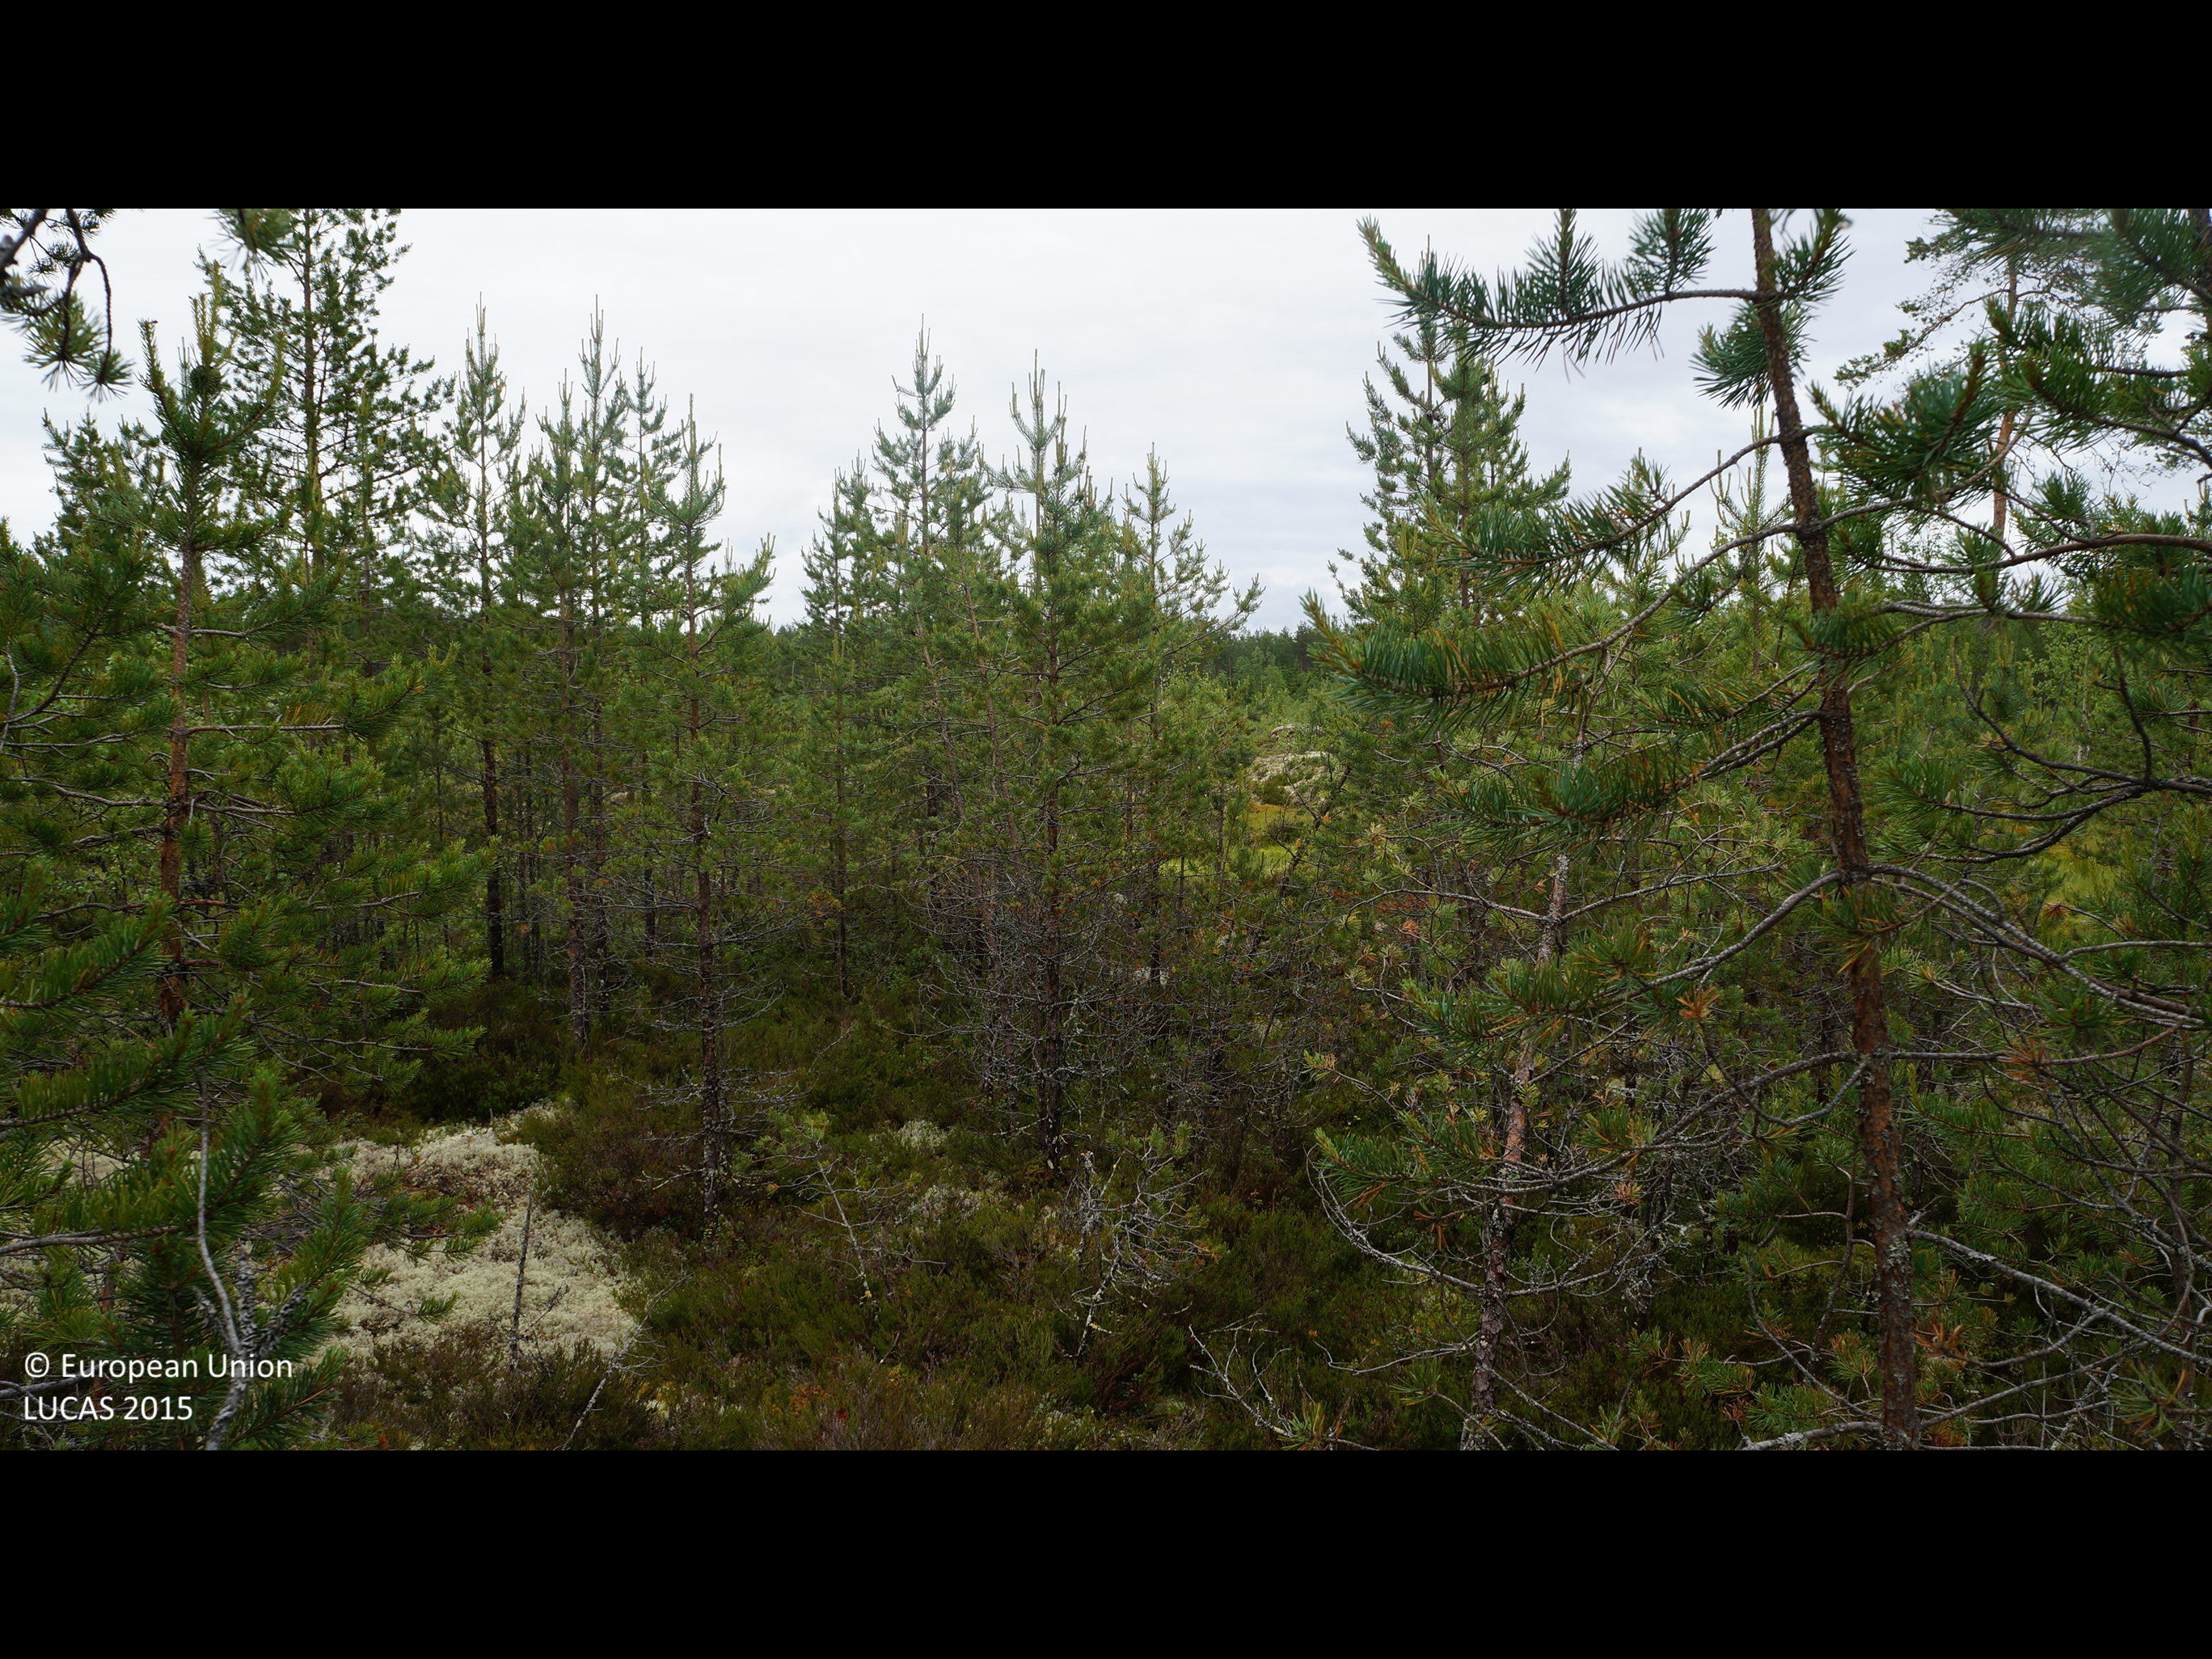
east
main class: Woodland
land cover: Pine dominated coniferous woodland
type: boreal forest
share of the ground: 25 - 50 %
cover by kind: coniferous forest trees 40 %, shrubs 30 %, lichens and mosses 25 %, broadleaved forest trees 5 %
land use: Forestry
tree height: > 5 m
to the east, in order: Pine dominated coniferous woodland; Tracks; Pine dominated coniferous woodland; Spontaneously vegetated surfaces; Ditches and canals; Spontaneously vegetated surfaces; Broadleaved woodland; Ditches and canals; Broadleaved woodland; Pine dominated coniferous woodland
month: June
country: FI
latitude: 64.3387
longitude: 24.6653
